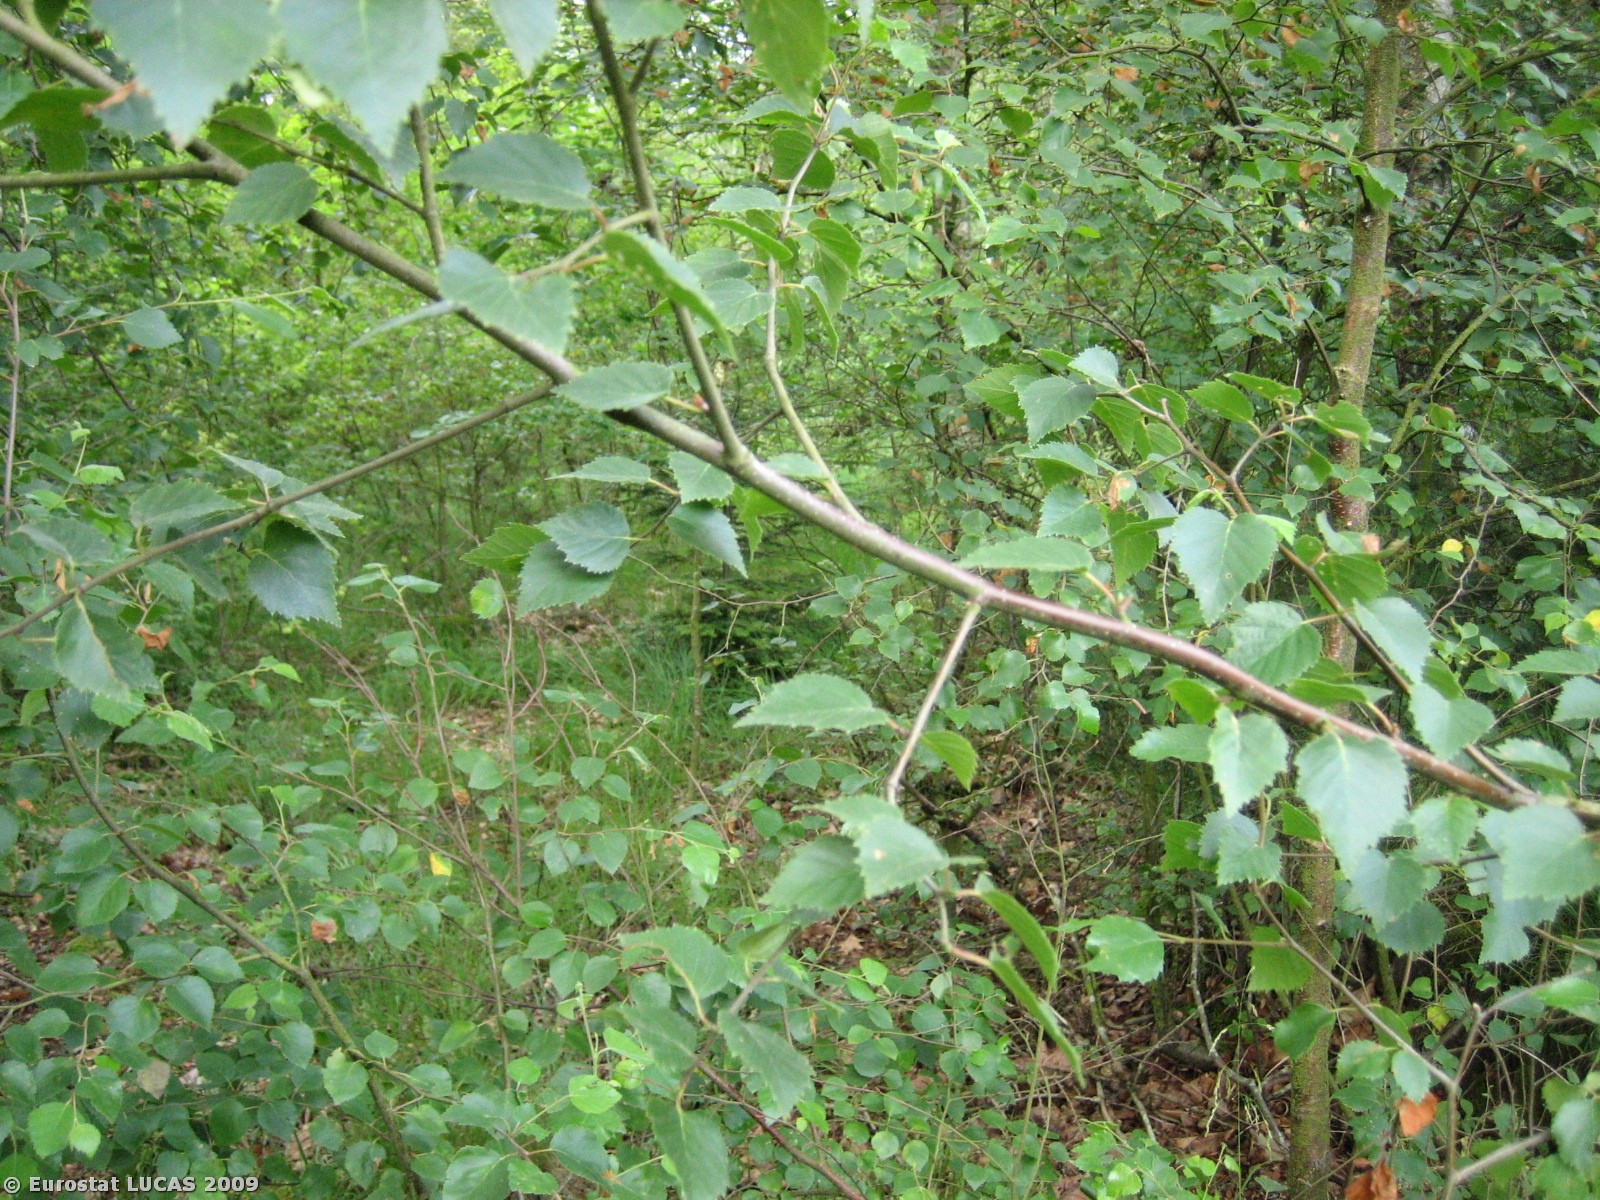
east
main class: Woodland
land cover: Mixed woodland
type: acidophilous oak and oak-birch forest
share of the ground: > 75 %
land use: Forestry
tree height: > 5 m
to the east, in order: Mixed woodland; Tracks; Mixed woodland; Railways; Grass margins; Fences; Grassland without tree/shrub cover; Mixed woodland; Broadleaved woodland; Coniferous woodland; Broadleaved woodland; Ditches and canals; Broadleaved woodland
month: July
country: DK
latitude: 55.5489
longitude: 8.4322
